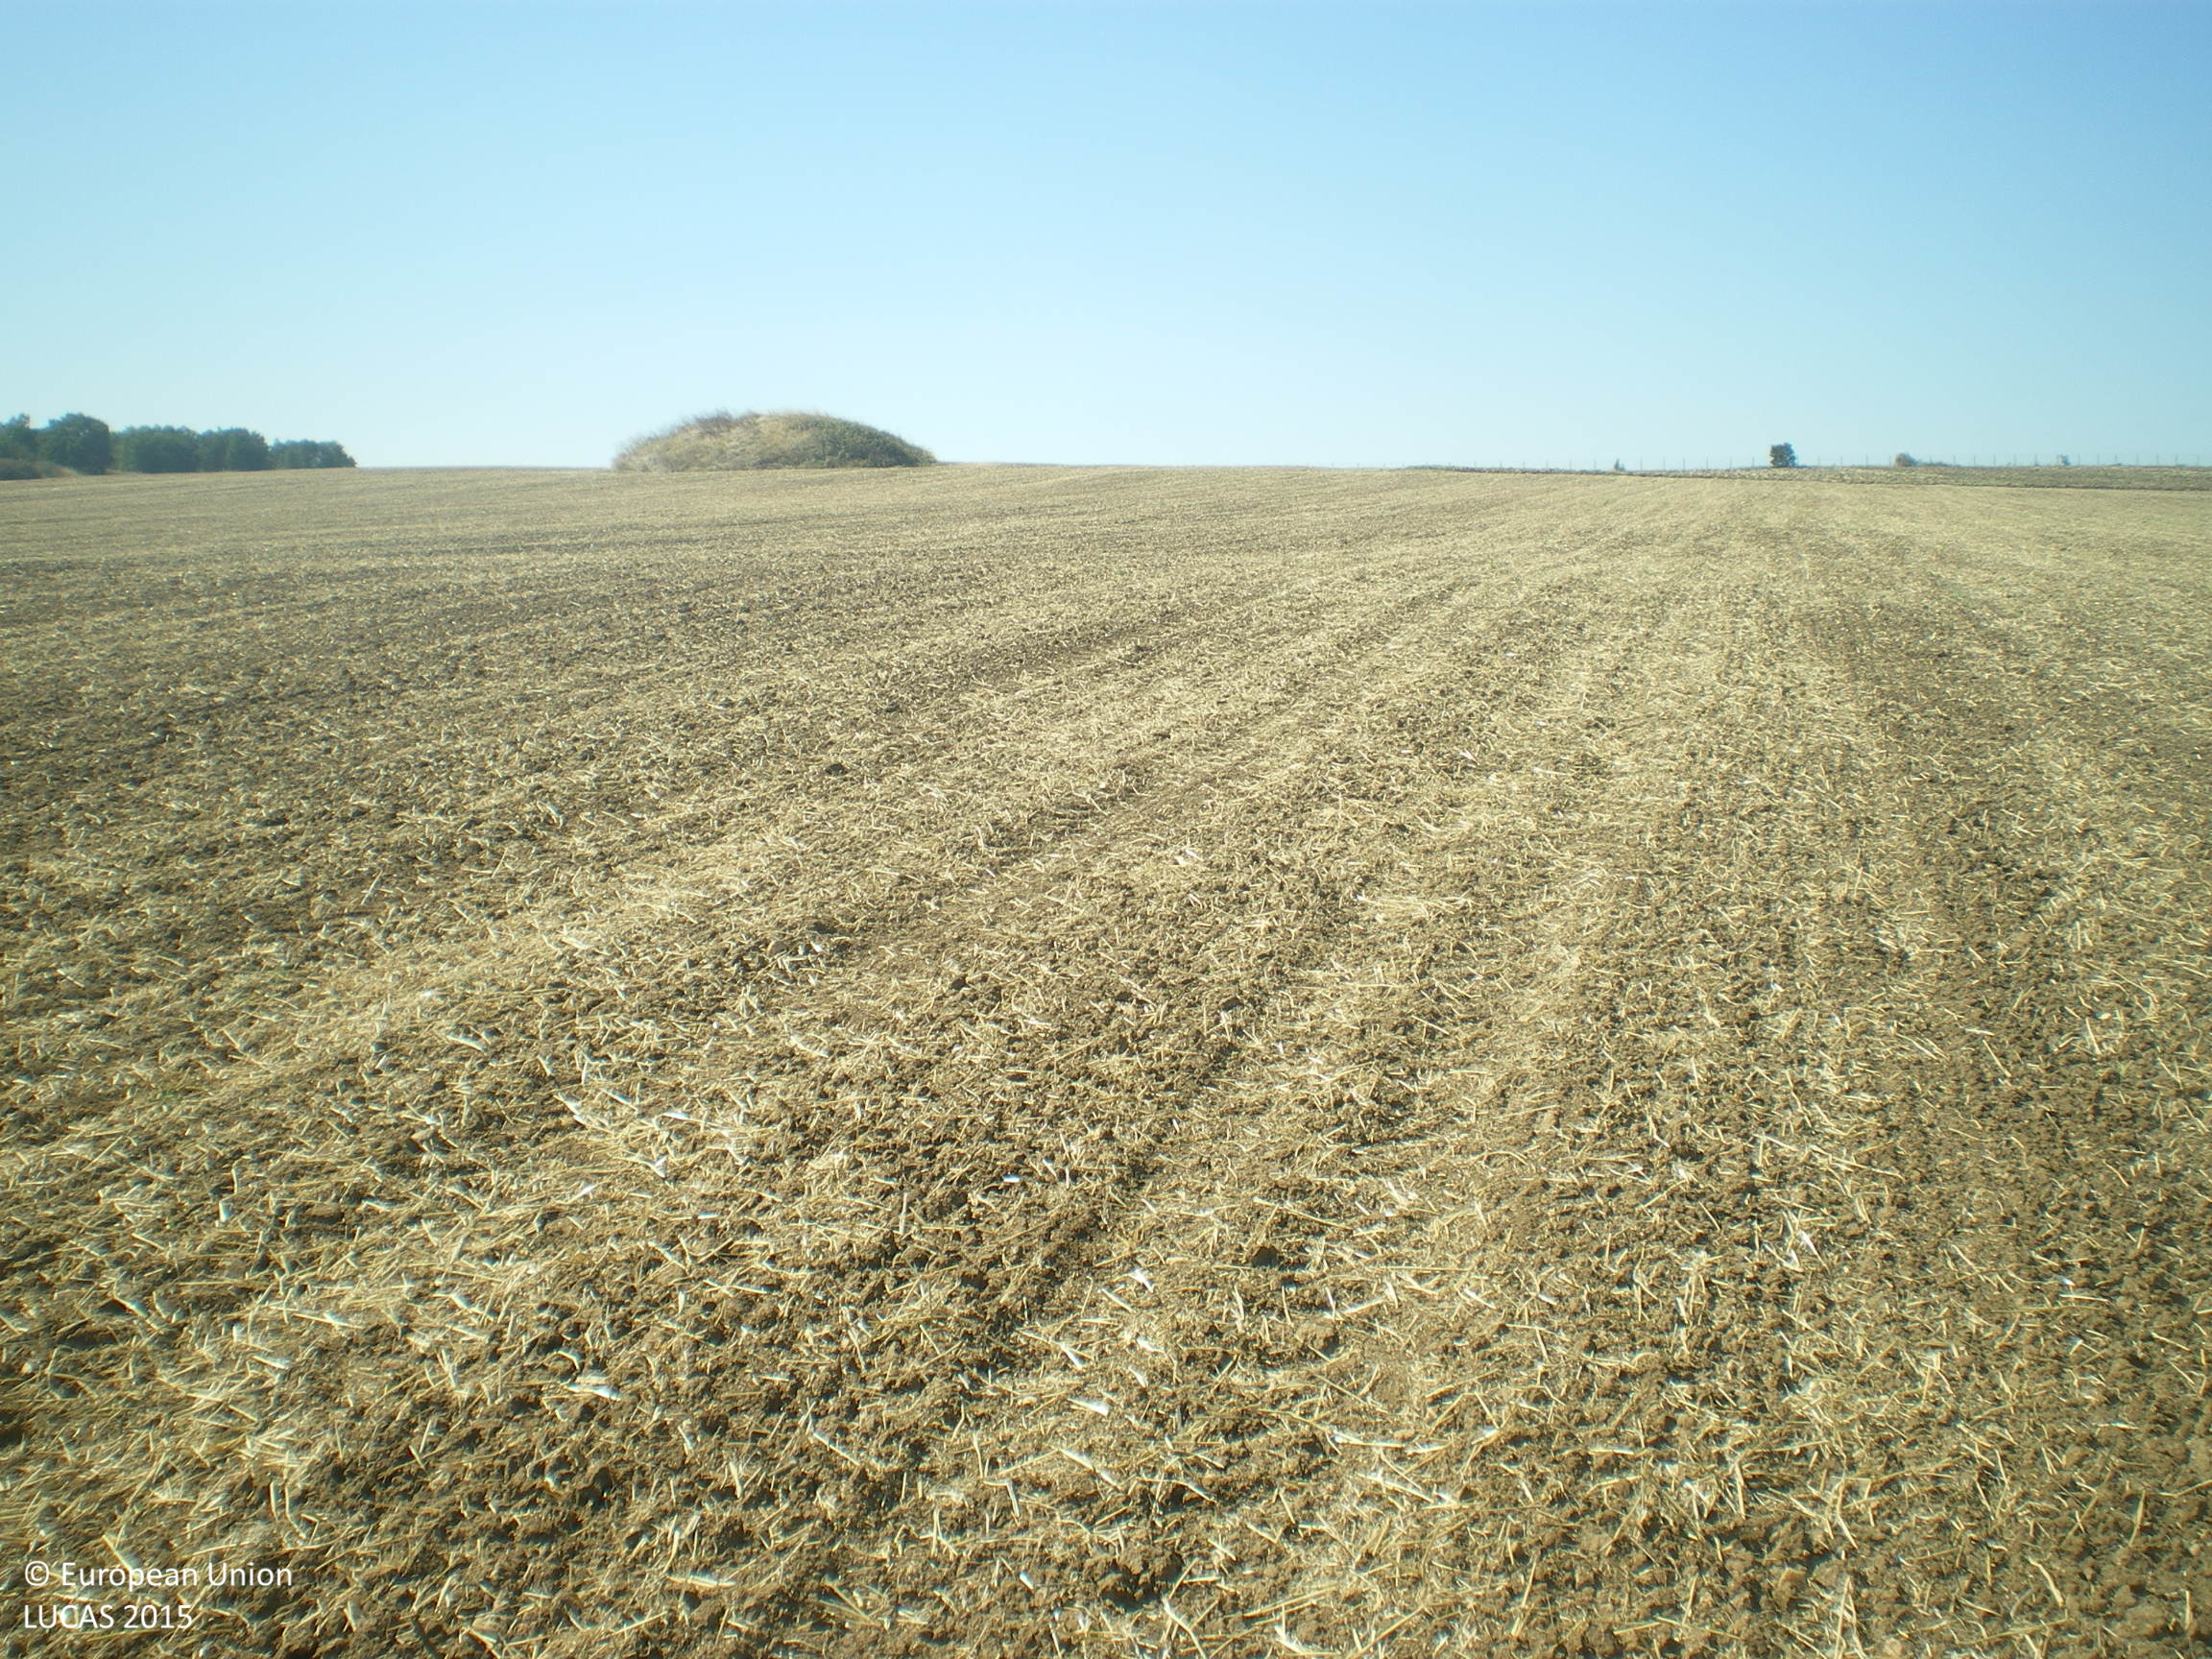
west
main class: Cropland
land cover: Common wheat
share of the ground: < 10 %
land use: Agriculture (excluding fallow land and kitchen gardens)
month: September
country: BG
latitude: 41.7775
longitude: 26.3327
